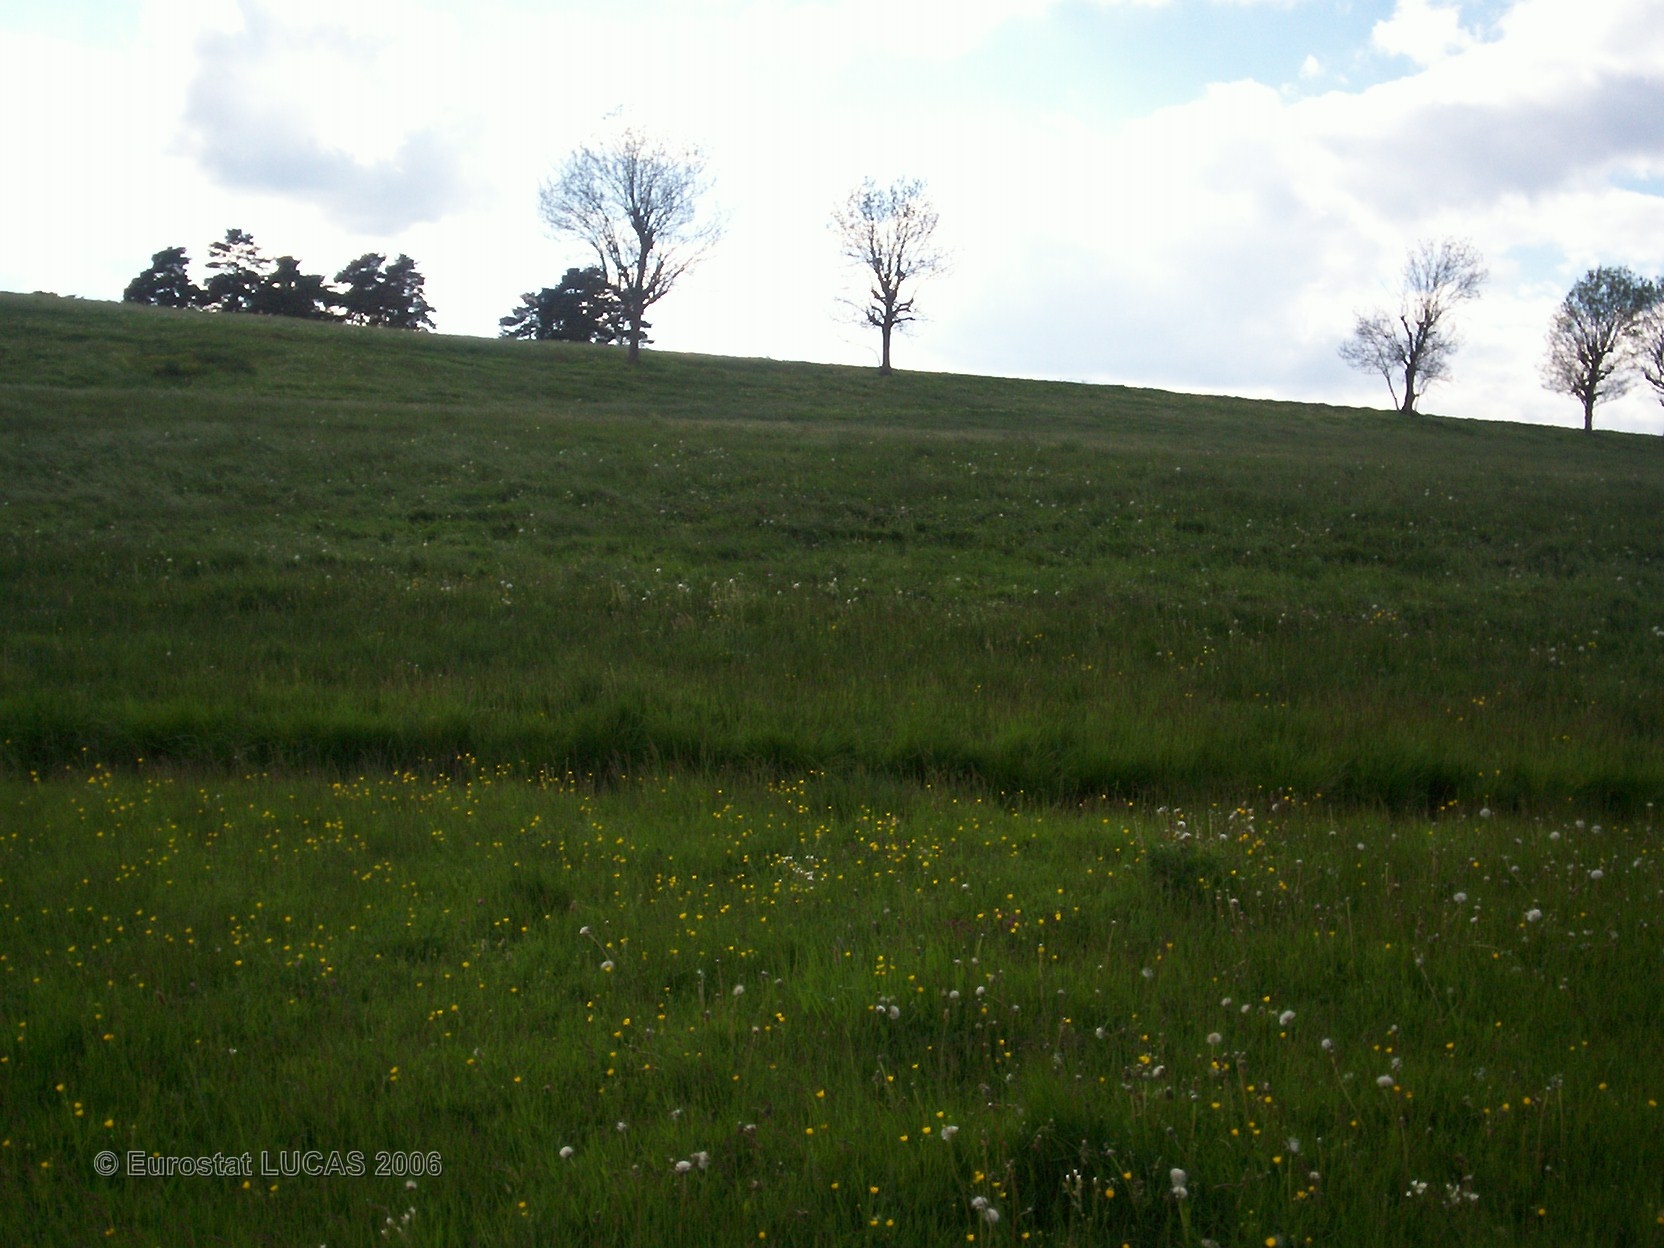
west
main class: Grassland
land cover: Grassland without tree/shrub cover
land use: Agriculture (excluding fallow land and kitchen gardens)
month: May
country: FR
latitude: 44.7013
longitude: 3.4038
